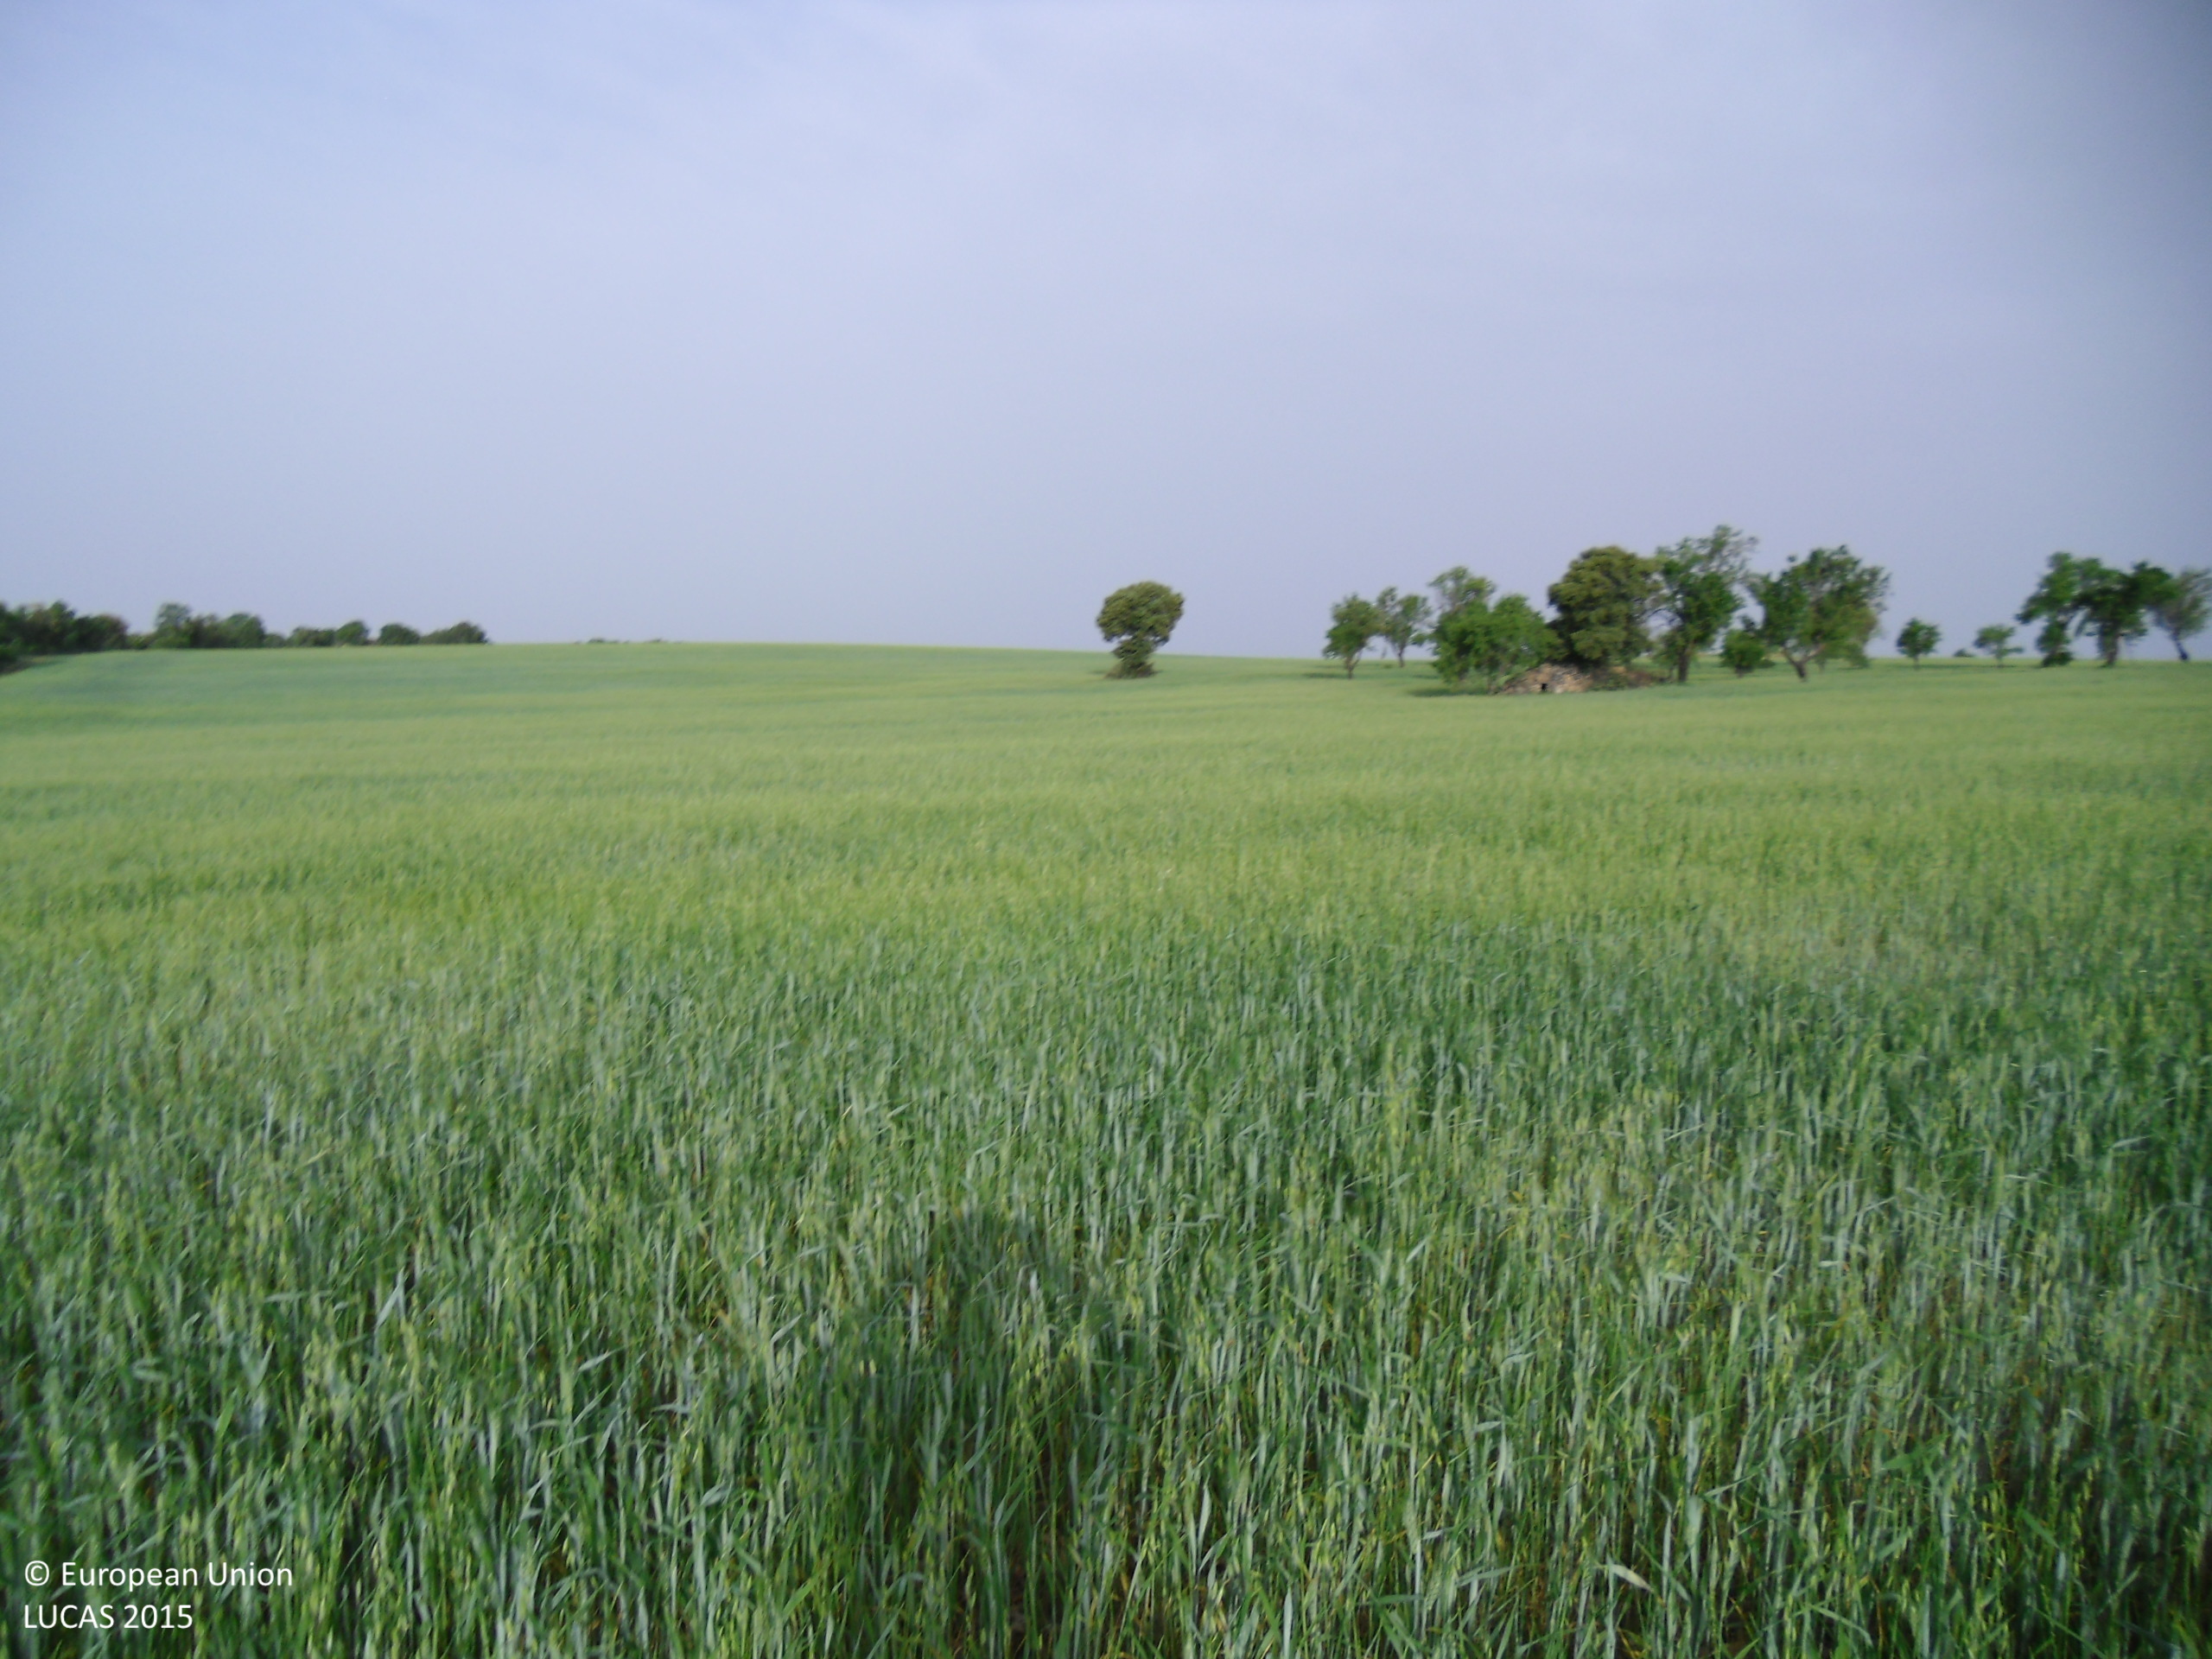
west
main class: Cropland
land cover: Common wheat
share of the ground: > 75 %
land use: Agriculture (excluding fallow land and kitchen gardens)
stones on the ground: < 10 %
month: May
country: ES
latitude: 40.5089
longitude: -2.9041
